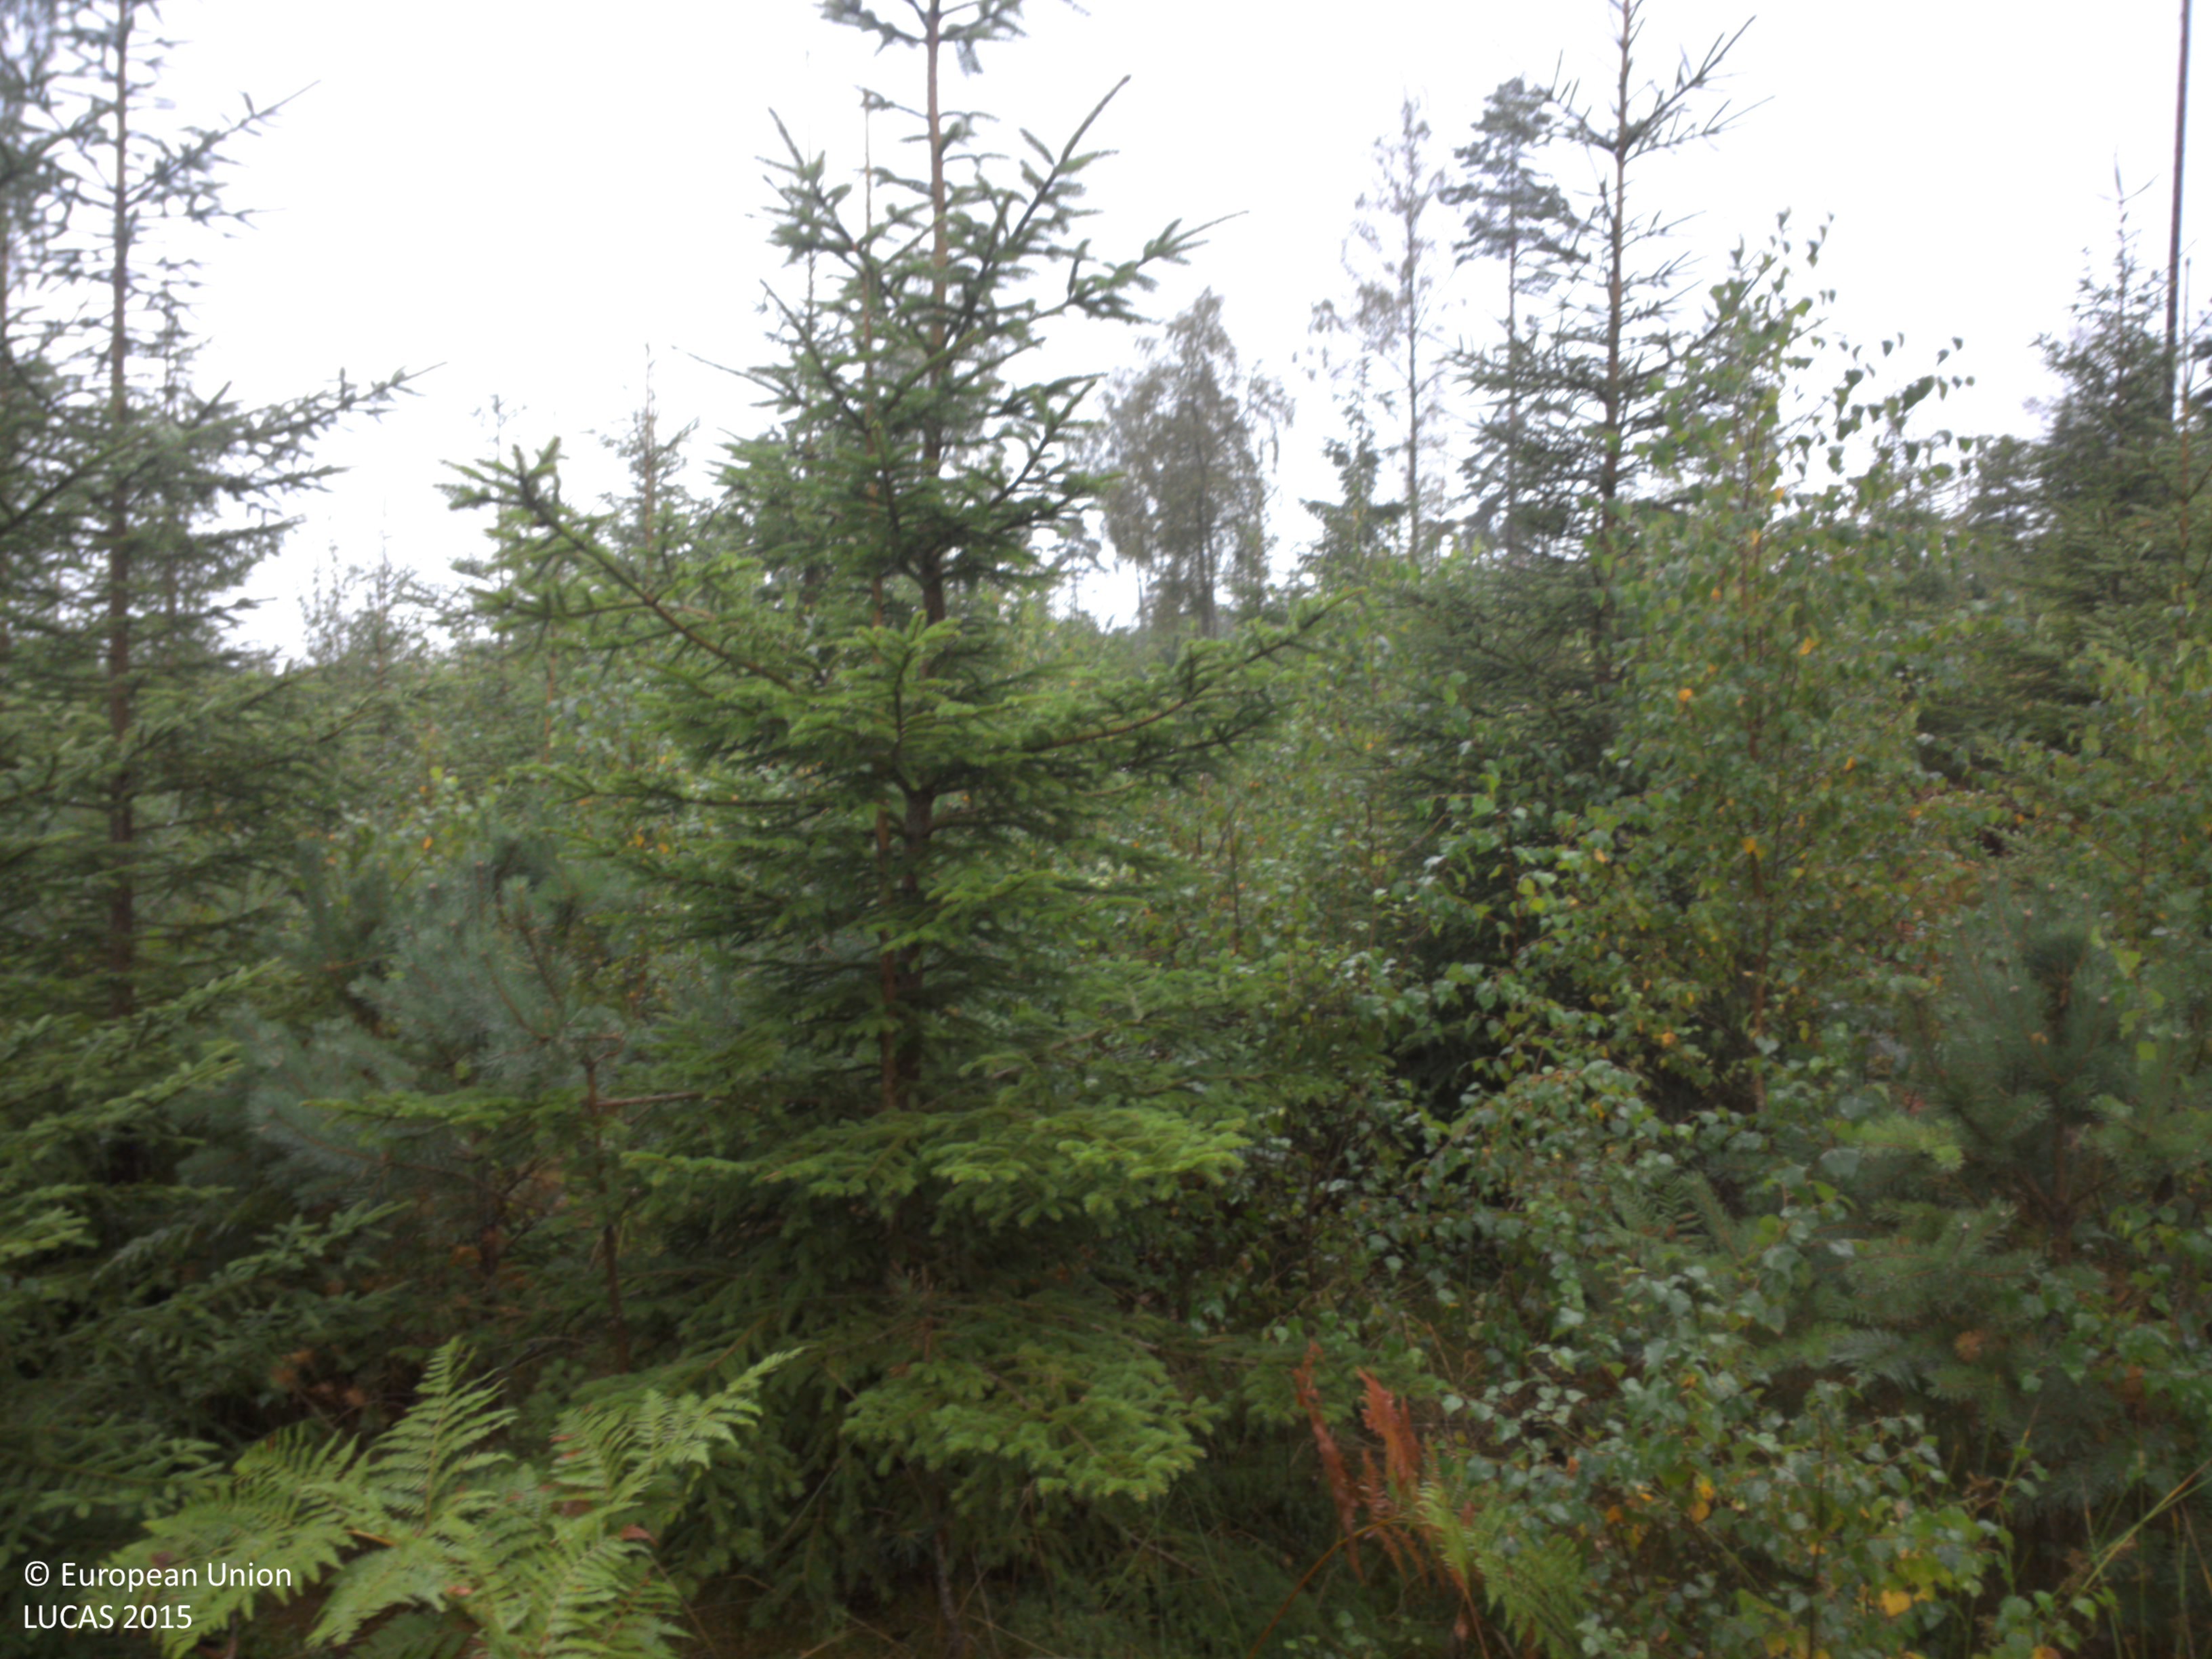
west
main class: Woodland
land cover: Spruce dominated mixed woodland
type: boreal forest
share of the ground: 50 - 75 %
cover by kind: coniferous forest trees 50 %, broadleaved forest trees 20 %, shrubs 15 %, herbaceous plants 10 %, lichens and mosses 5 %
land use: Forestry
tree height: < 5 m
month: August
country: SE
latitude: 58.0735
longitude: 12.3185
